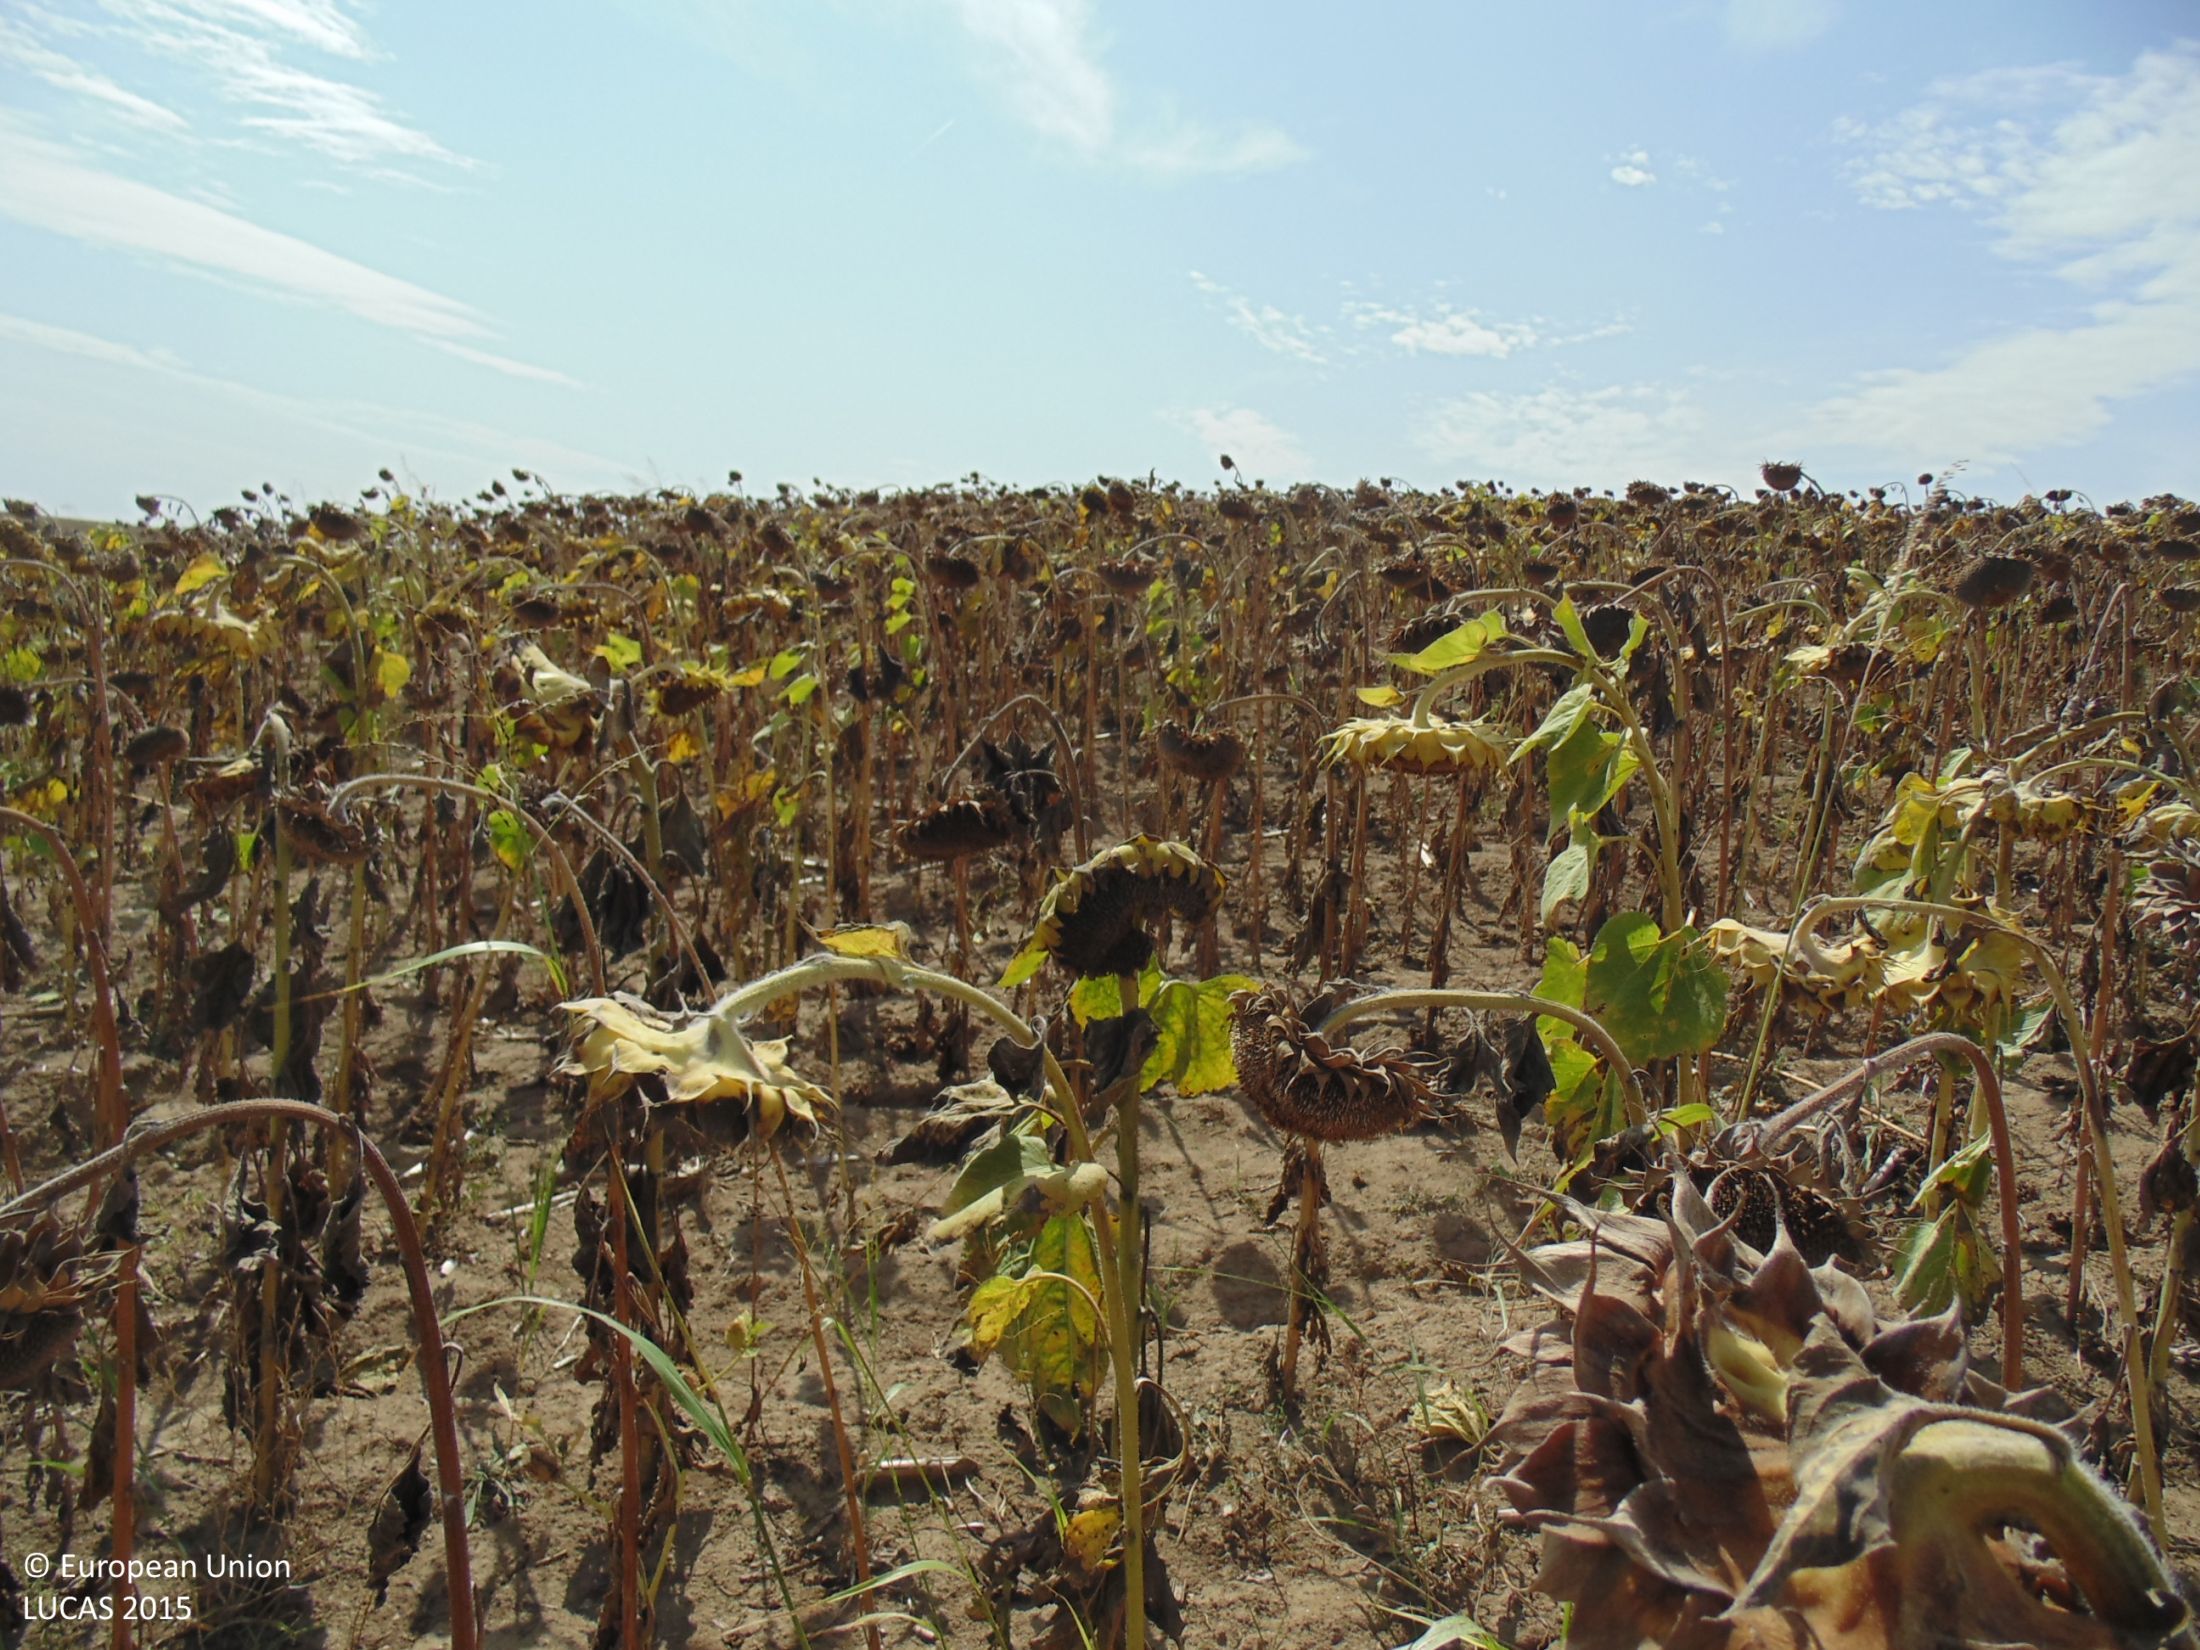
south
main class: Cropland
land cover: Sunflower
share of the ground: > 75 %
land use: Agriculture (excluding fallow land and kitchen gardens)
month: September
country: BG
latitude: 44.0093
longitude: 27.1786
